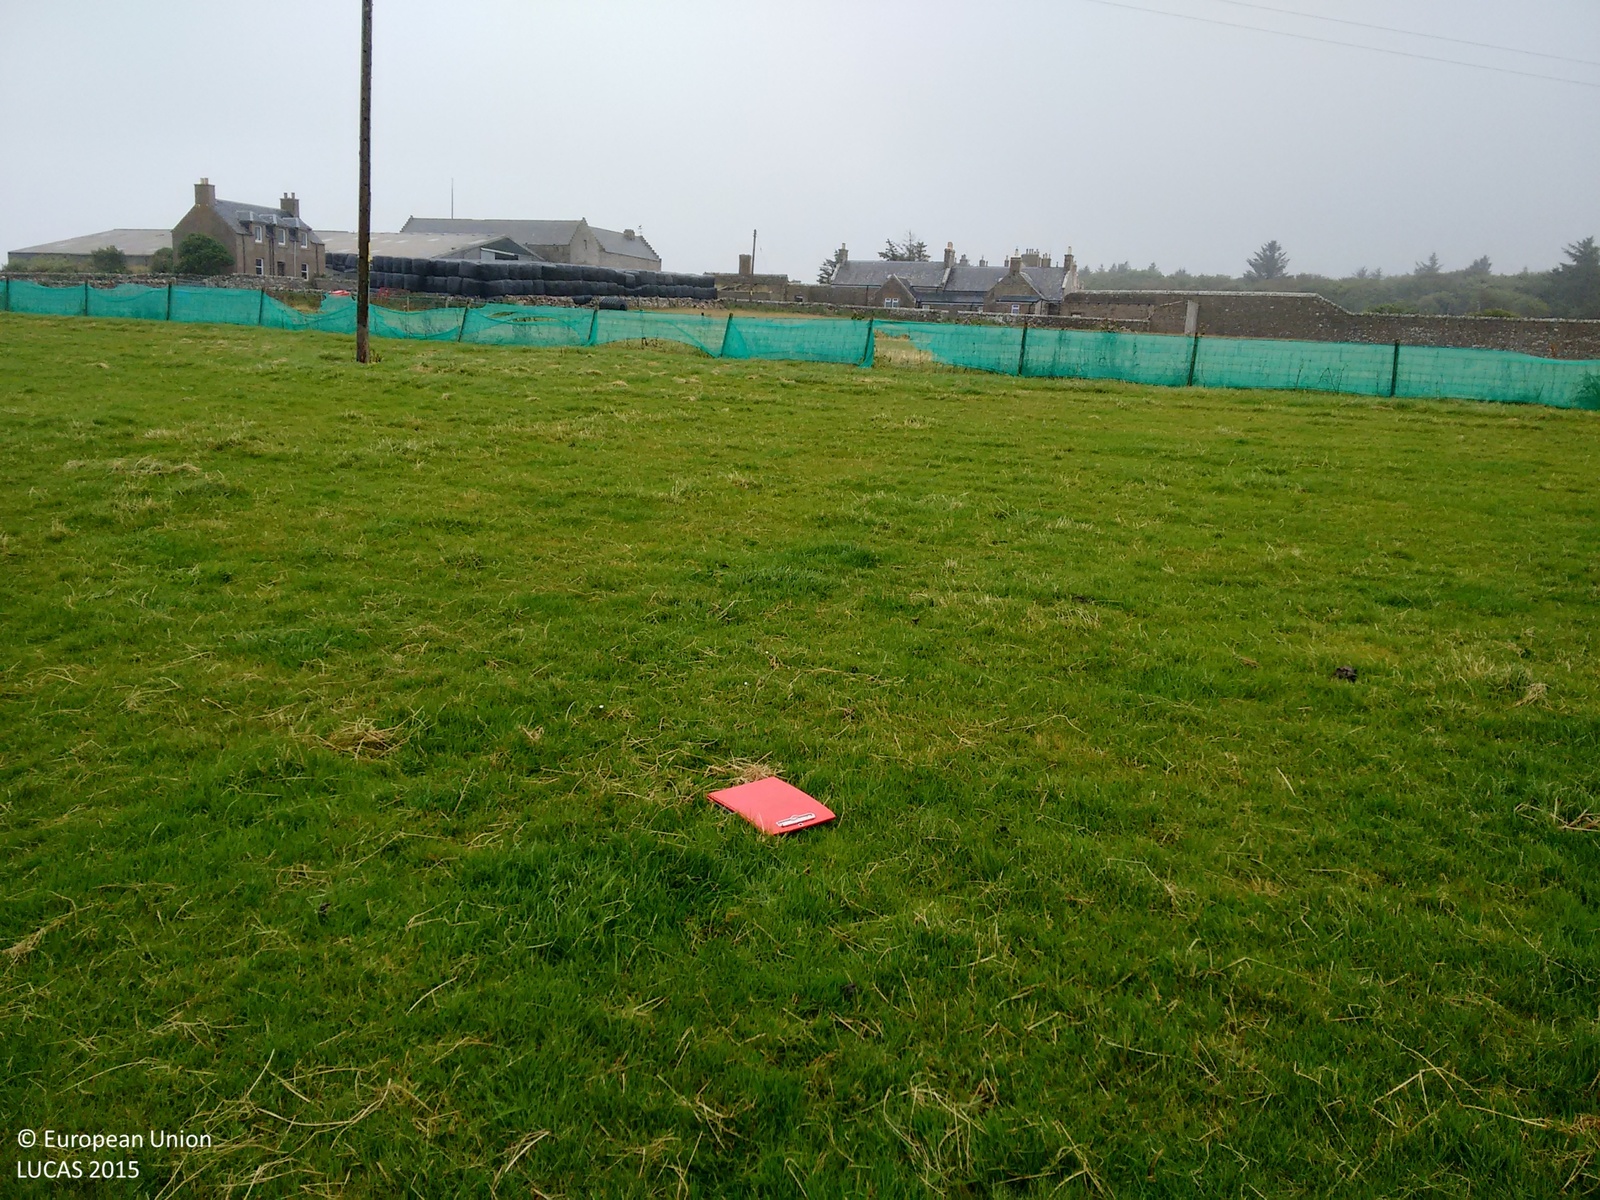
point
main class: Grassland
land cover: Grassland without tree/shrub cover
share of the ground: > 75 %
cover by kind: herbaceous plants 100 %
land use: Agriculture (excluding fallow land and kitchen gardens)
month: September
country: GB
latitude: 58.5635
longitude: -3.8051
